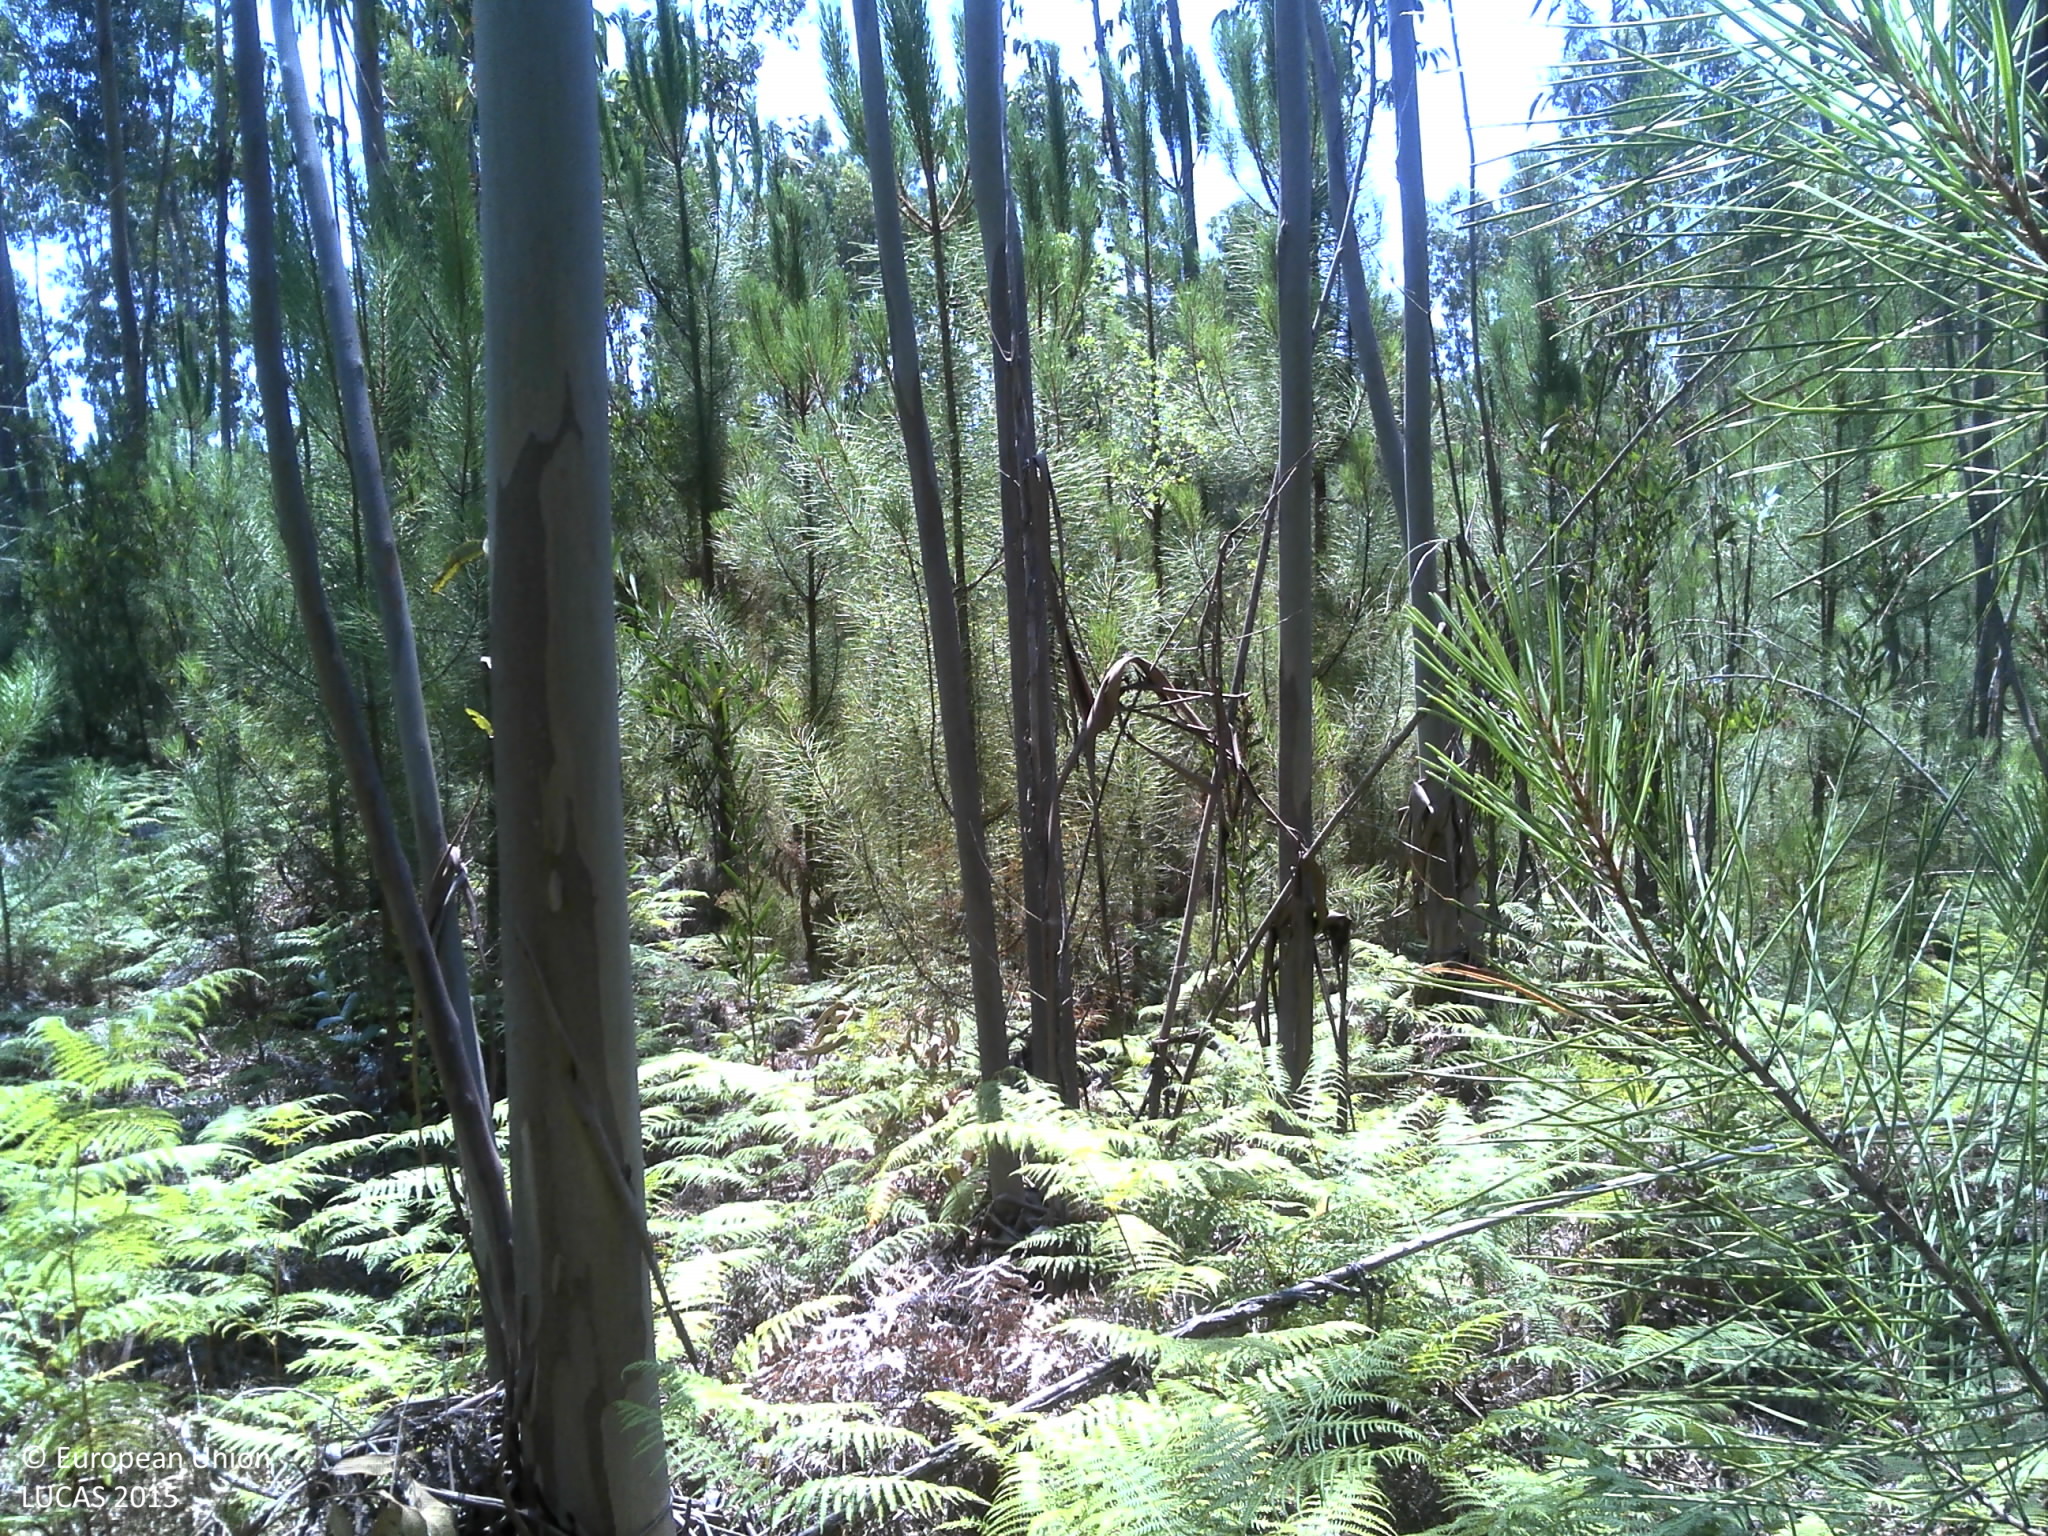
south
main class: Woodland
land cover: Pine dominated mixed woodland
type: coniferous forest of the mediterranean region
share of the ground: 50 - 75 %
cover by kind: coniferous forest trees 50 %, broadleaved forest trees 25 %, shrubs 25 %
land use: Forestry
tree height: > 5 m
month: July
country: PT
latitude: 39.9883
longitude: -8.6000
